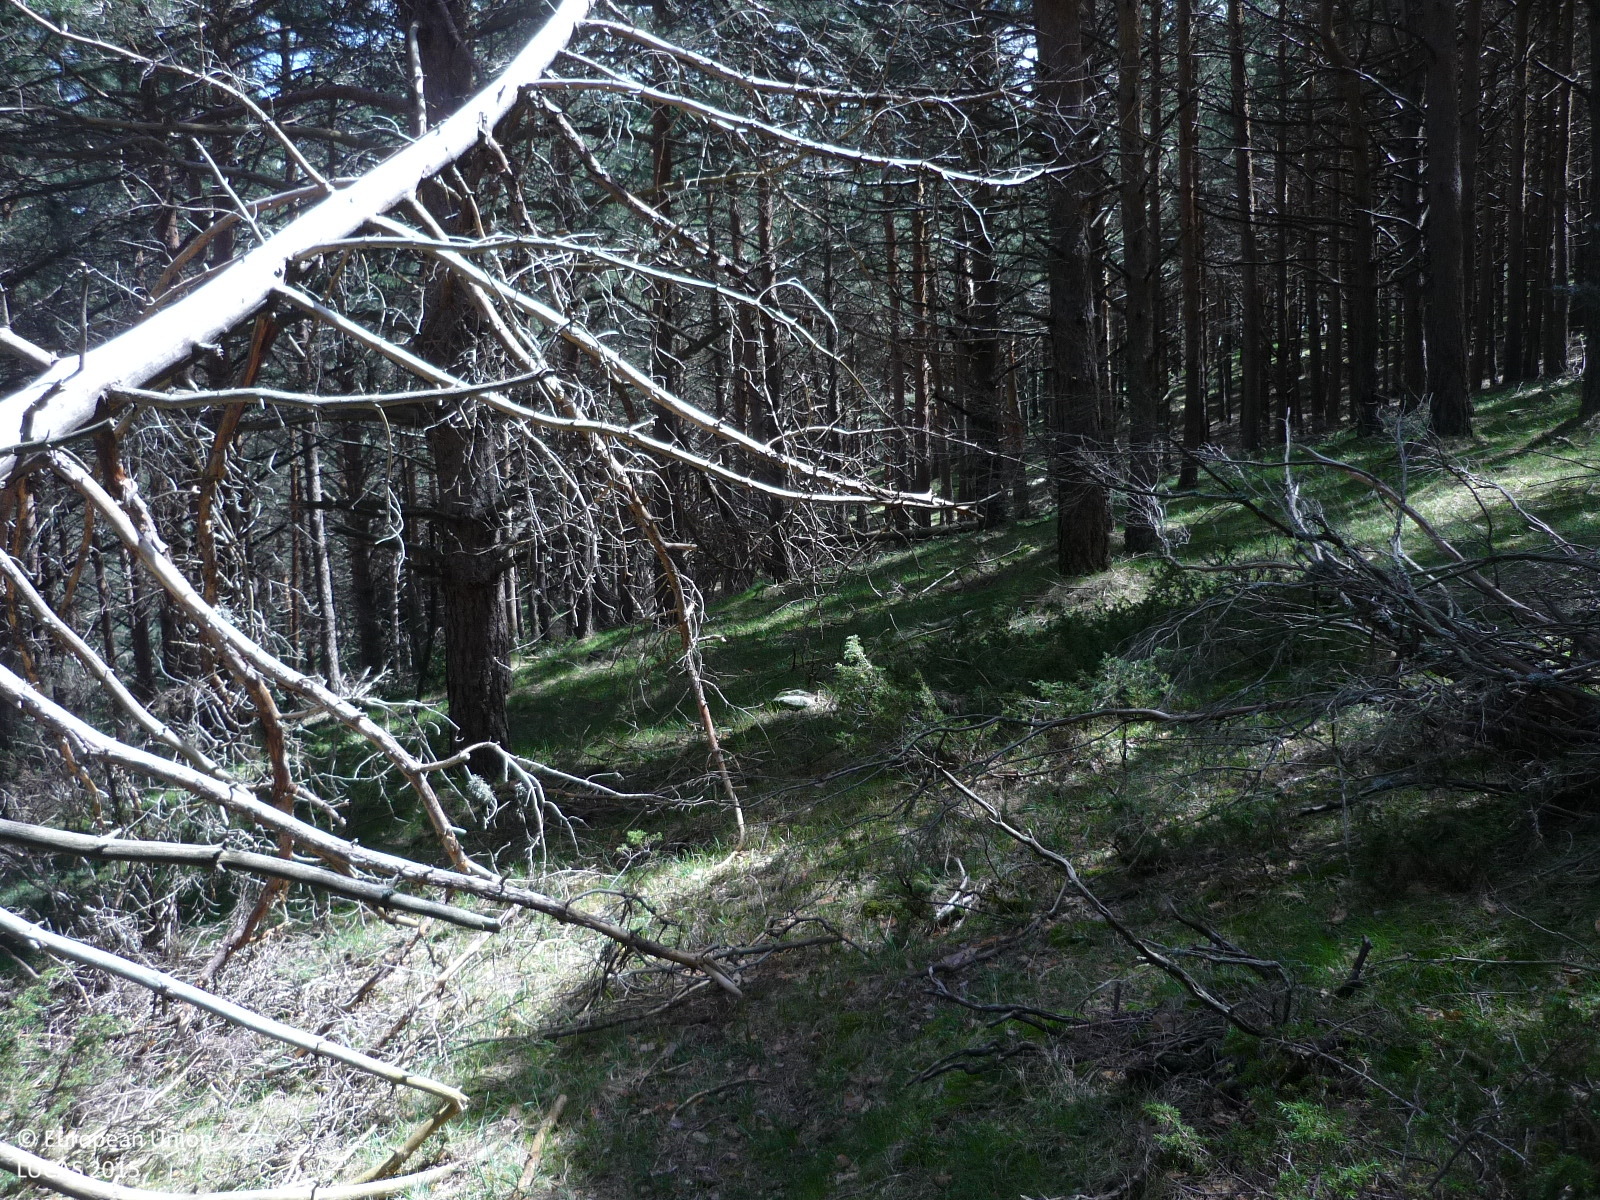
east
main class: Woodland
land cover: Pine dominated coniferous woodland
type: coniferous forest of the mediterranean region
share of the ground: > 75 %
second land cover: Grassland without tree/shrub cover
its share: > 75 %
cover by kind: coniferous forest trees 90 %, herbaceous plants 10 %
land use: Forestry
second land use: Agriculture (excluding fallow land and kitchen gardens)
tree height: > 5 m
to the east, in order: Pine dominated coniferous woodland; Grassland without tree/shrub cover; Tracks; Pine dominated coniferous woodland
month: April
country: ES
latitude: 41.1265
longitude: -3.6122
